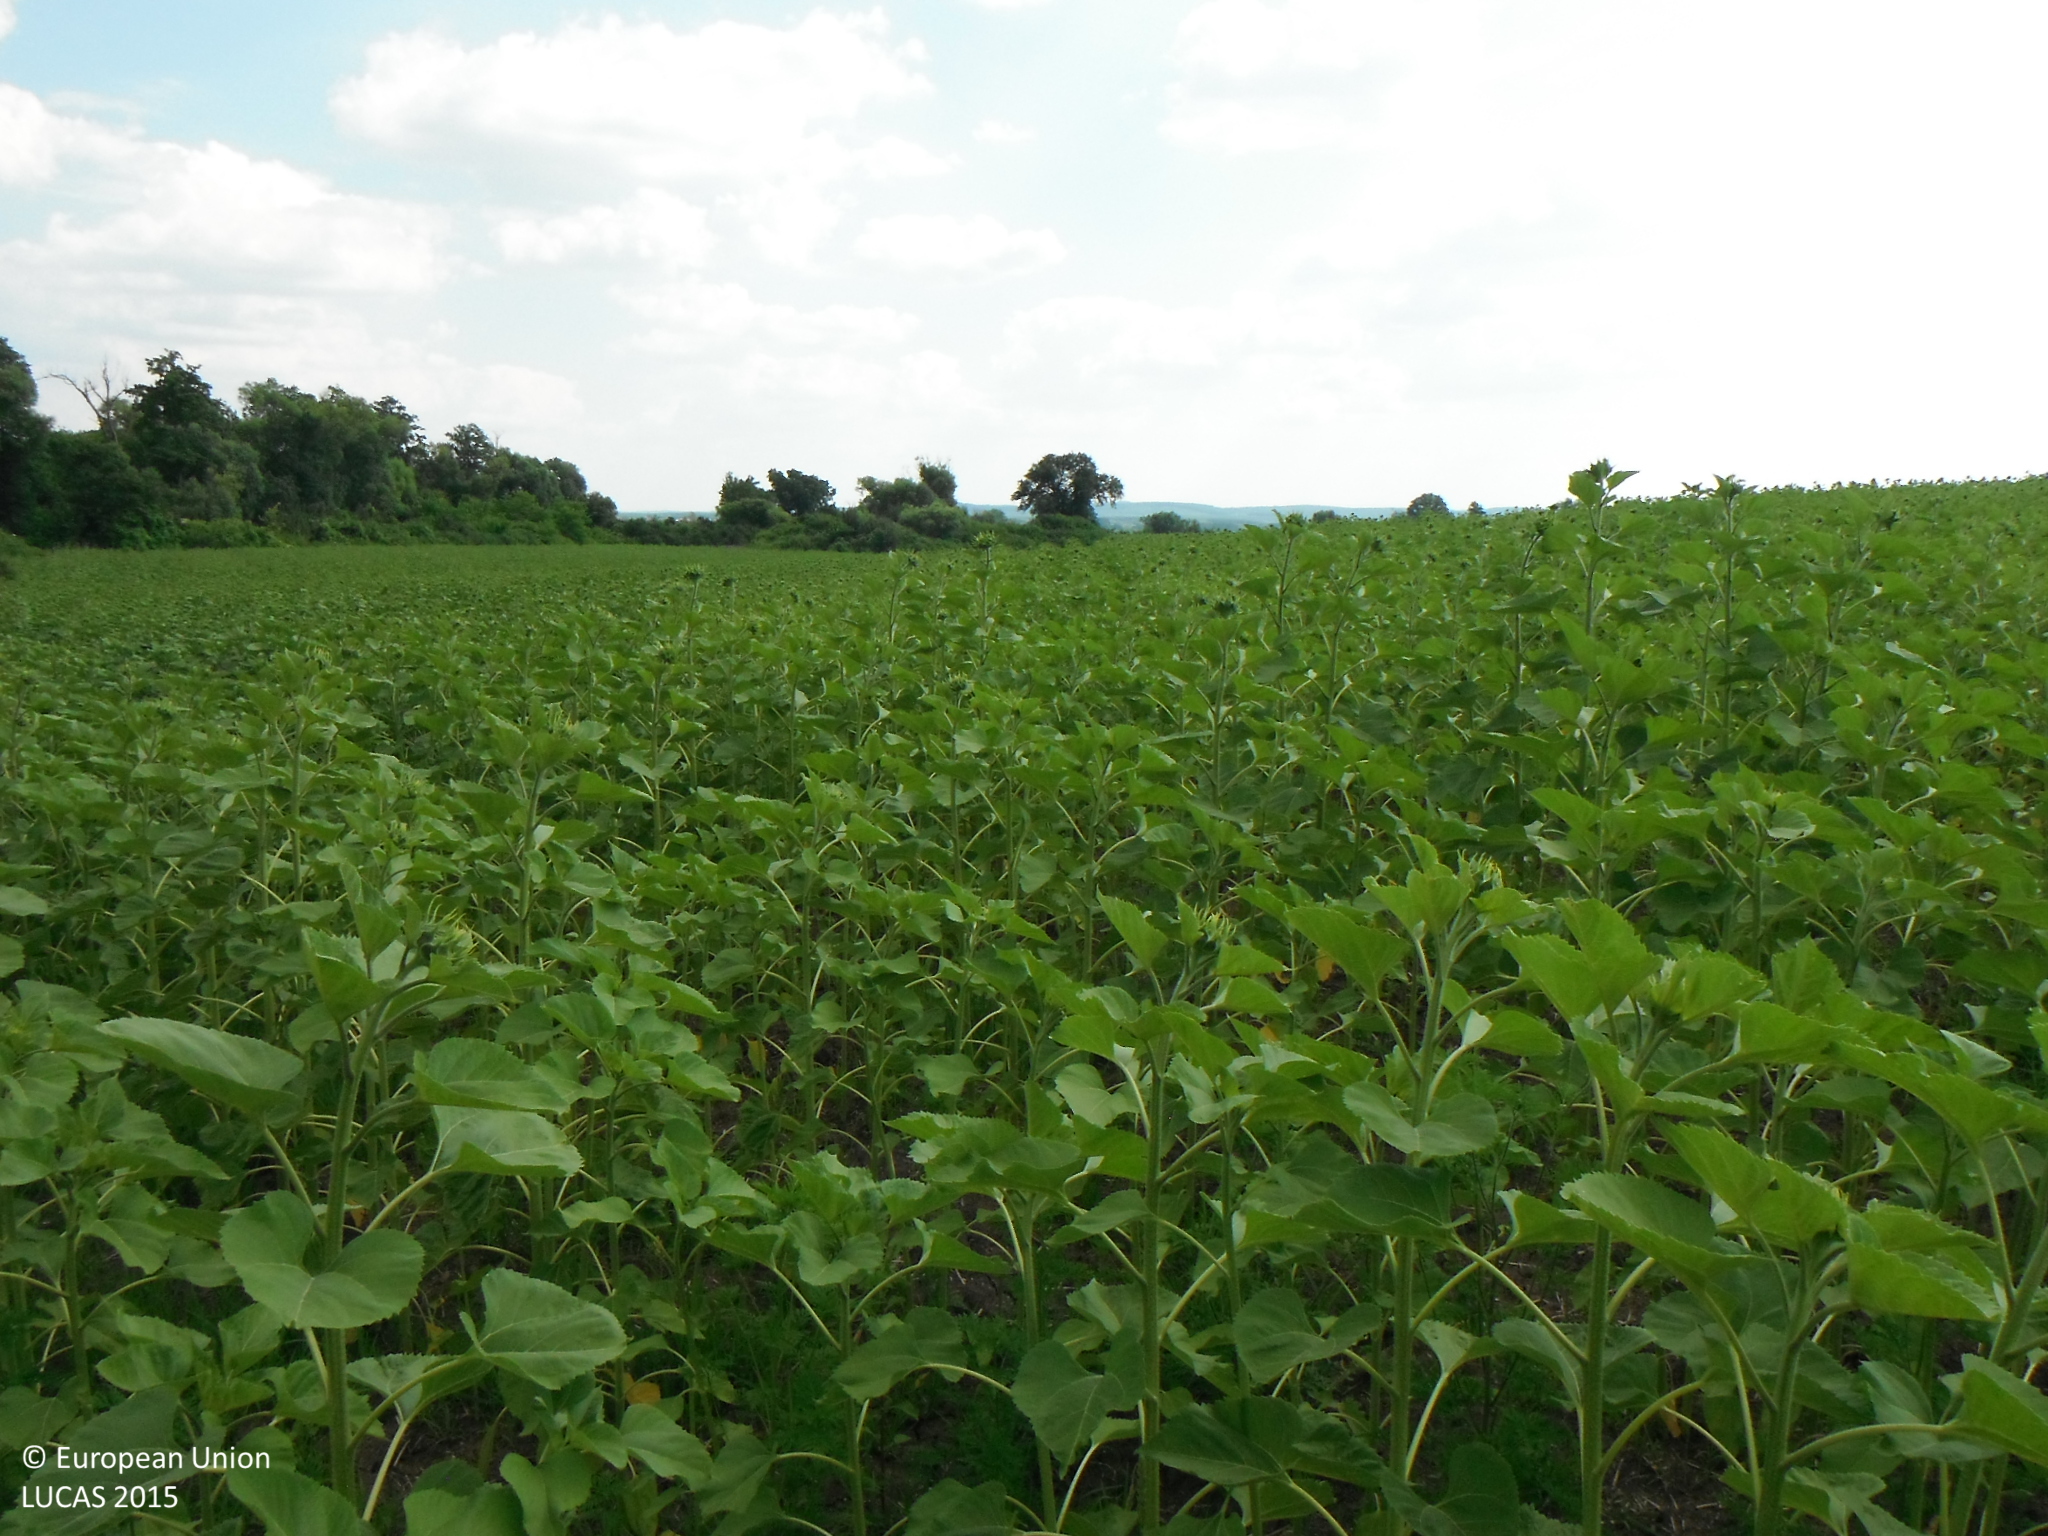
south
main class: Cropland
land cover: Sunflower
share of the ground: > 75 %
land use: Agriculture (excluding fallow land and kitchen gardens)
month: July
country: SK
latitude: 48.1035
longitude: 19.2746
